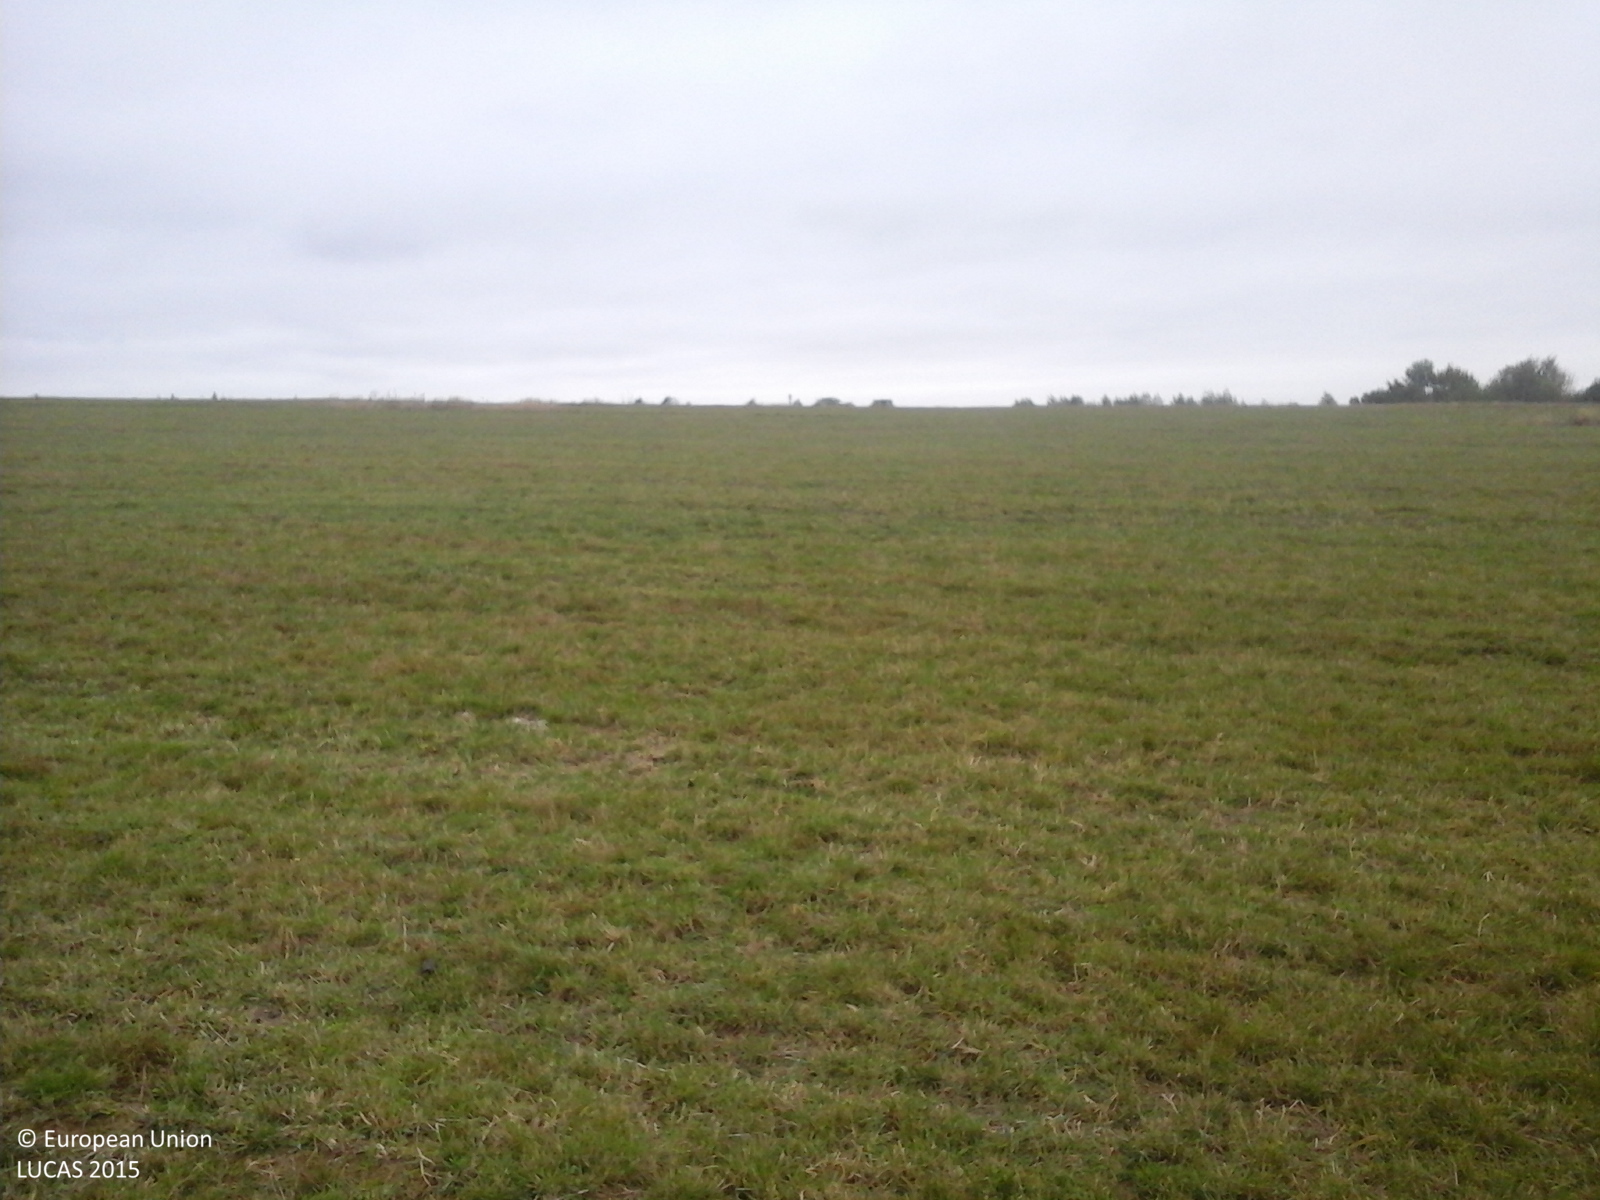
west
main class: Grassland
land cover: Grassland without tree/shrub cover
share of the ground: > 75 %
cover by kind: herbaceous plants 100 %
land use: Agriculture (excluding fallow land and kitchen gardens)
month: October
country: RO
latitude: 45.7282
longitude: 24.7215
